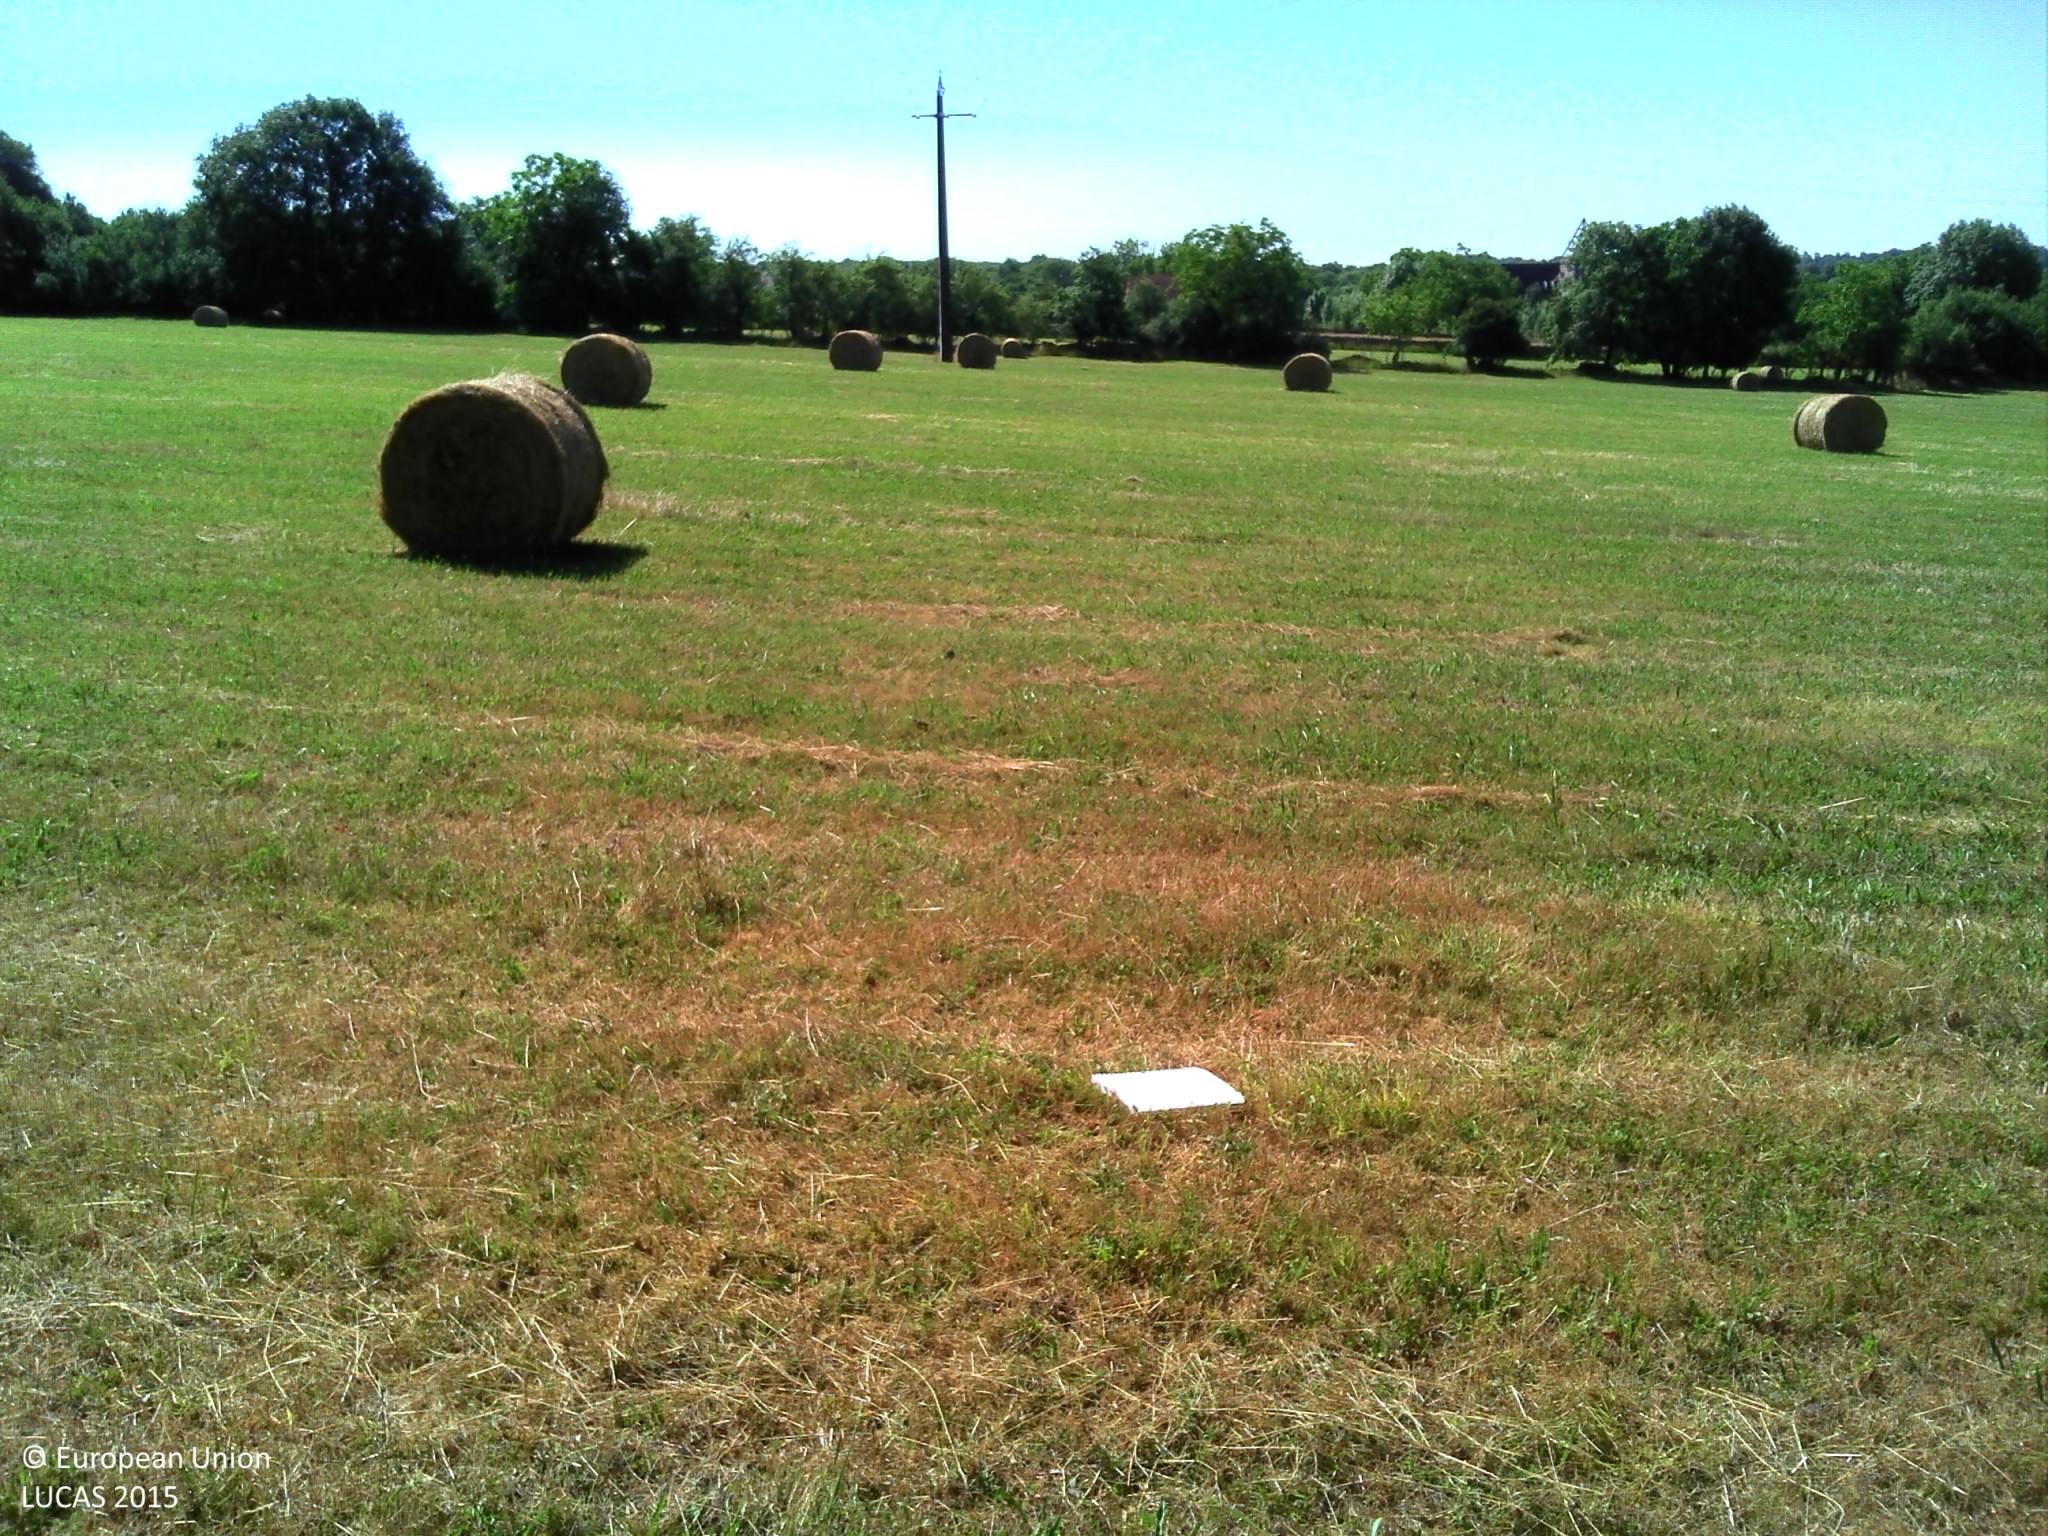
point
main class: Grassland
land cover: Grassland without tree/shrub cover
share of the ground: > 75 %
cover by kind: herbaceous plants 100 %
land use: Agriculture (excluding fallow land and kitchen gardens)
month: June
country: FR
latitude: 44.7504
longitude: 1.8009
